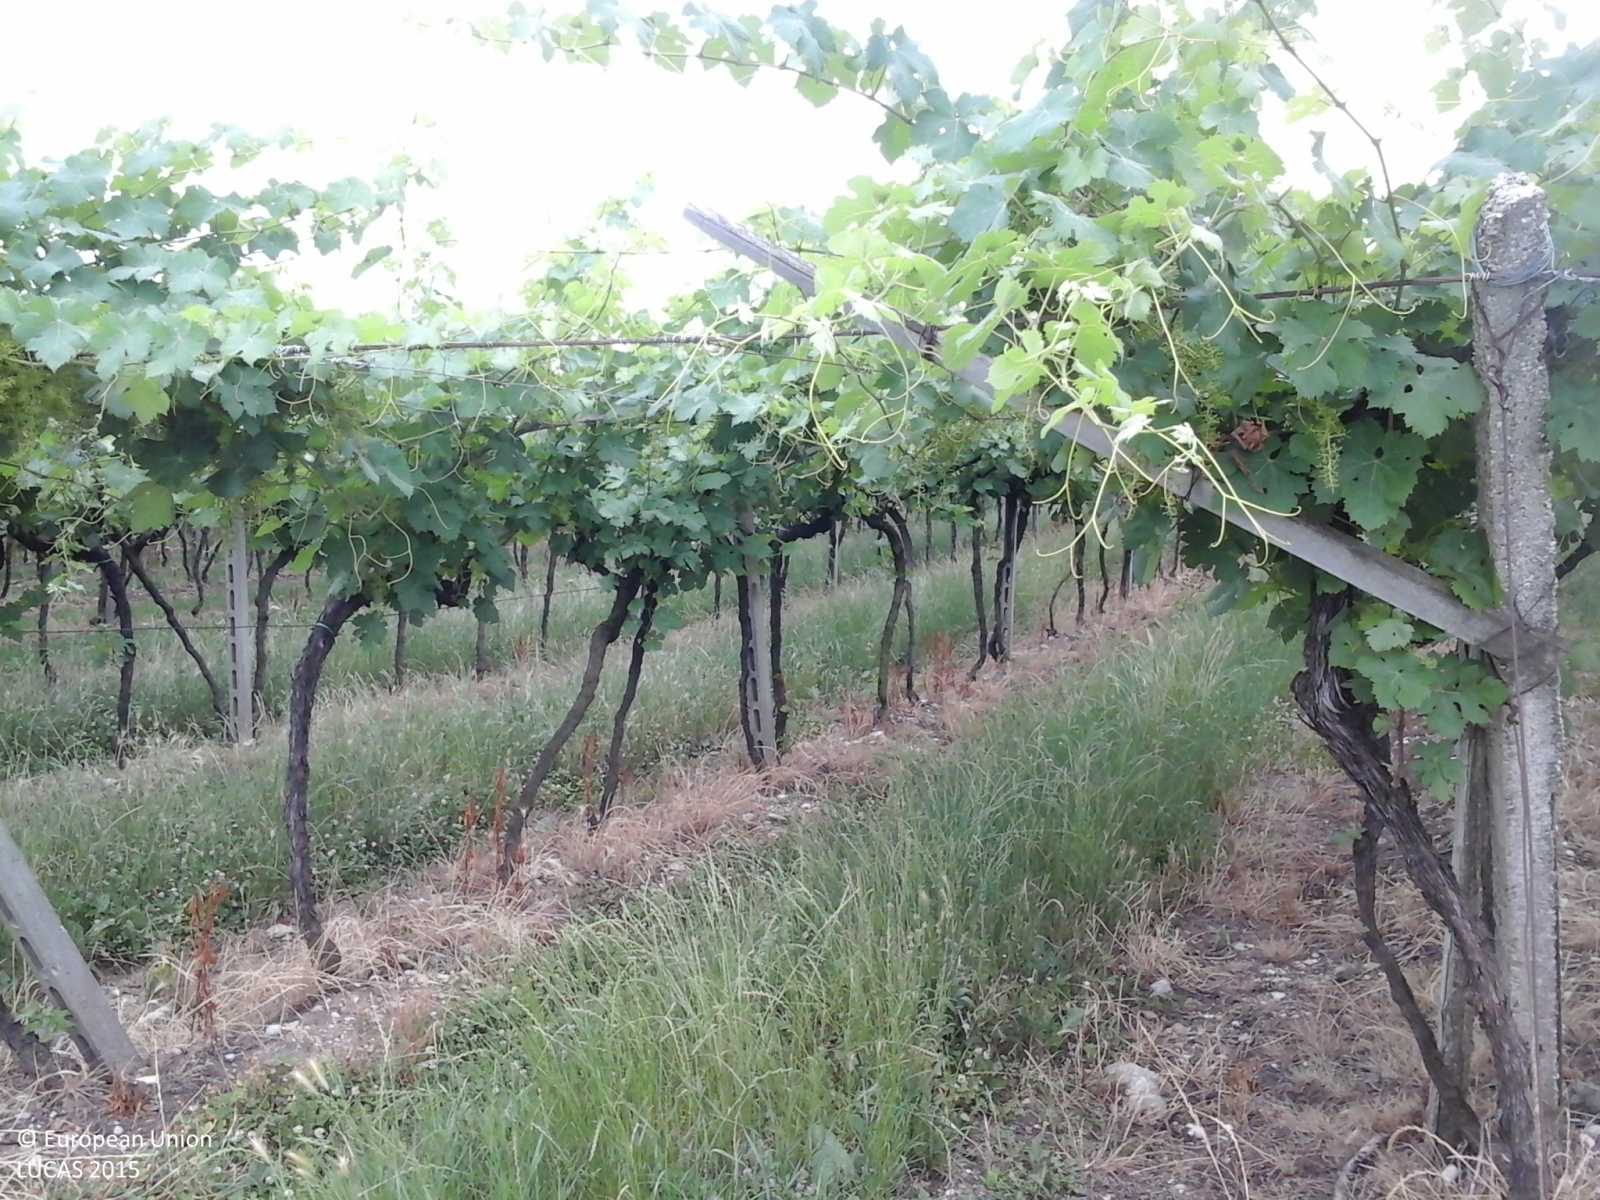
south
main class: Cropland
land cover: Vineyards
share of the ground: > 75 %
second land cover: Grassland without tree/shrub cover
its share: > 75 %
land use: Agriculture (excluding fallow land and kitchen gardens)
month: June
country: IT
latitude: 45.4293
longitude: 10.8039
